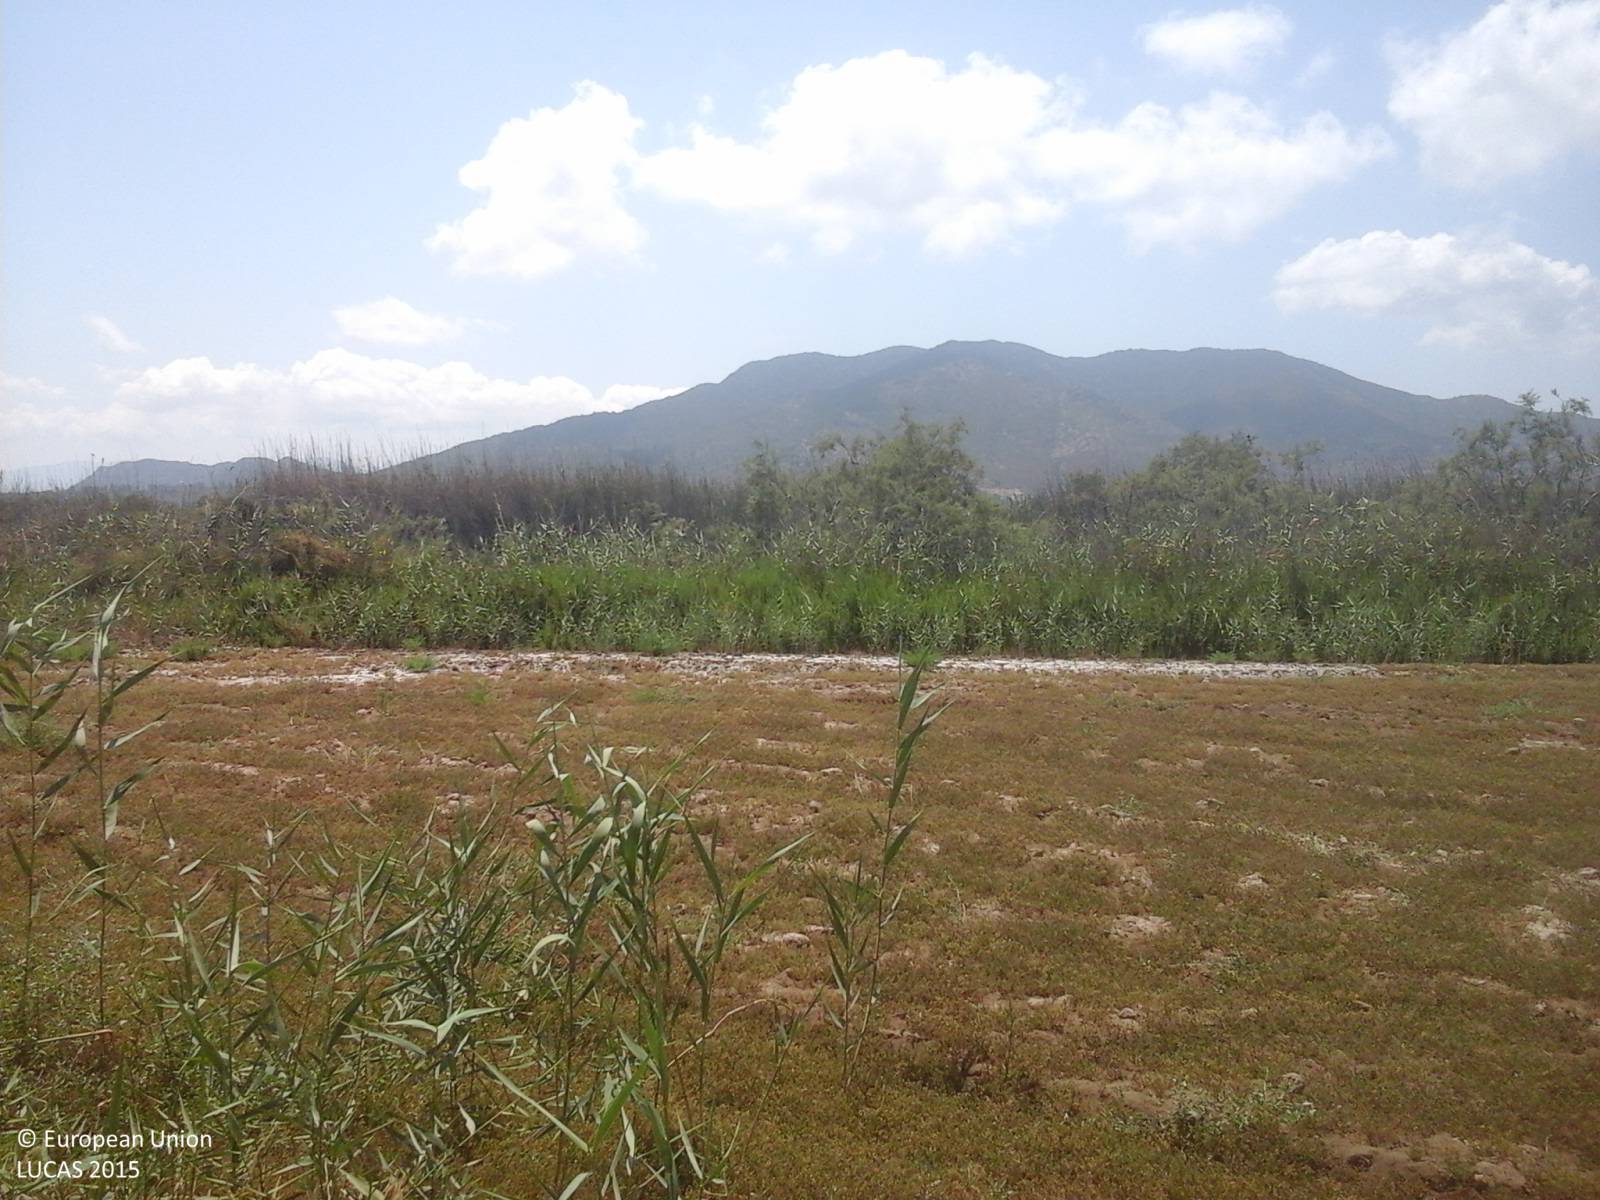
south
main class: Grassland
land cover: Spontaneously vegetated surfaces
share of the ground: > 75 %
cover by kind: herbaceous plants 75 %, unconsolidated bare surface 25 %
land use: Fallow land
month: July
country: IT
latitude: 39.4154
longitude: 9.6190
